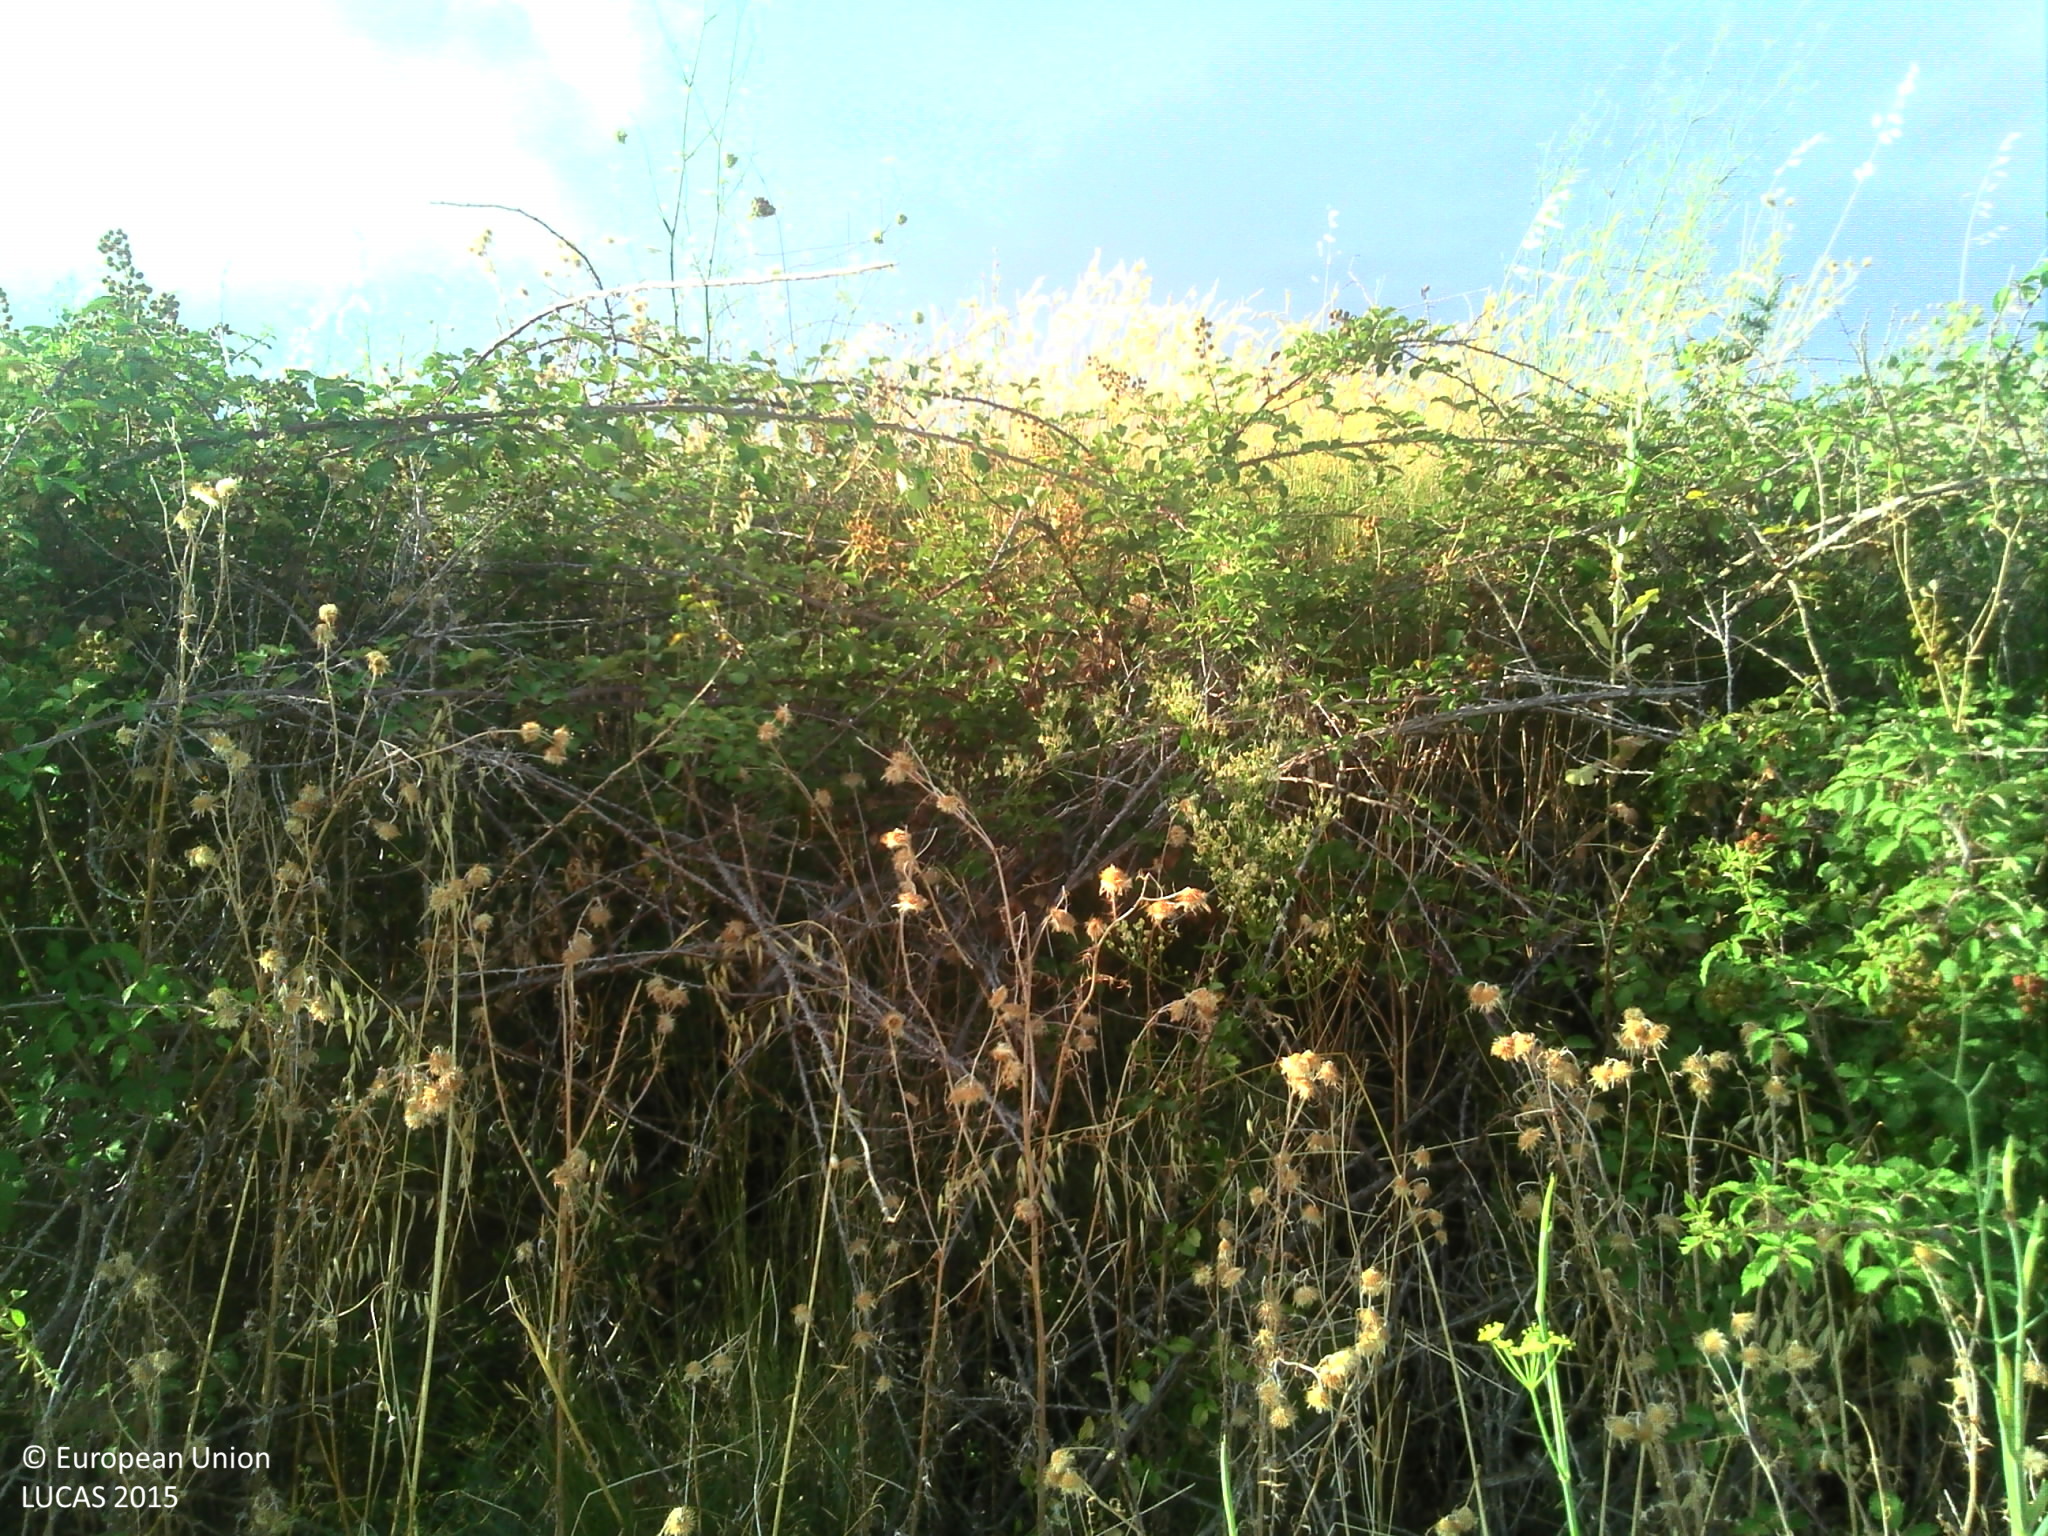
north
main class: Grassland
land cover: Spontaneously vegetated surfaces
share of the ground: > 75 %
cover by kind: herbaceous plants 90 %, shrubs 5 %, lichens and mosses 5 %
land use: Abandoned areas
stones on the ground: 25 - 50 %
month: July
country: FR
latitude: 43.3955
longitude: 3.0827
